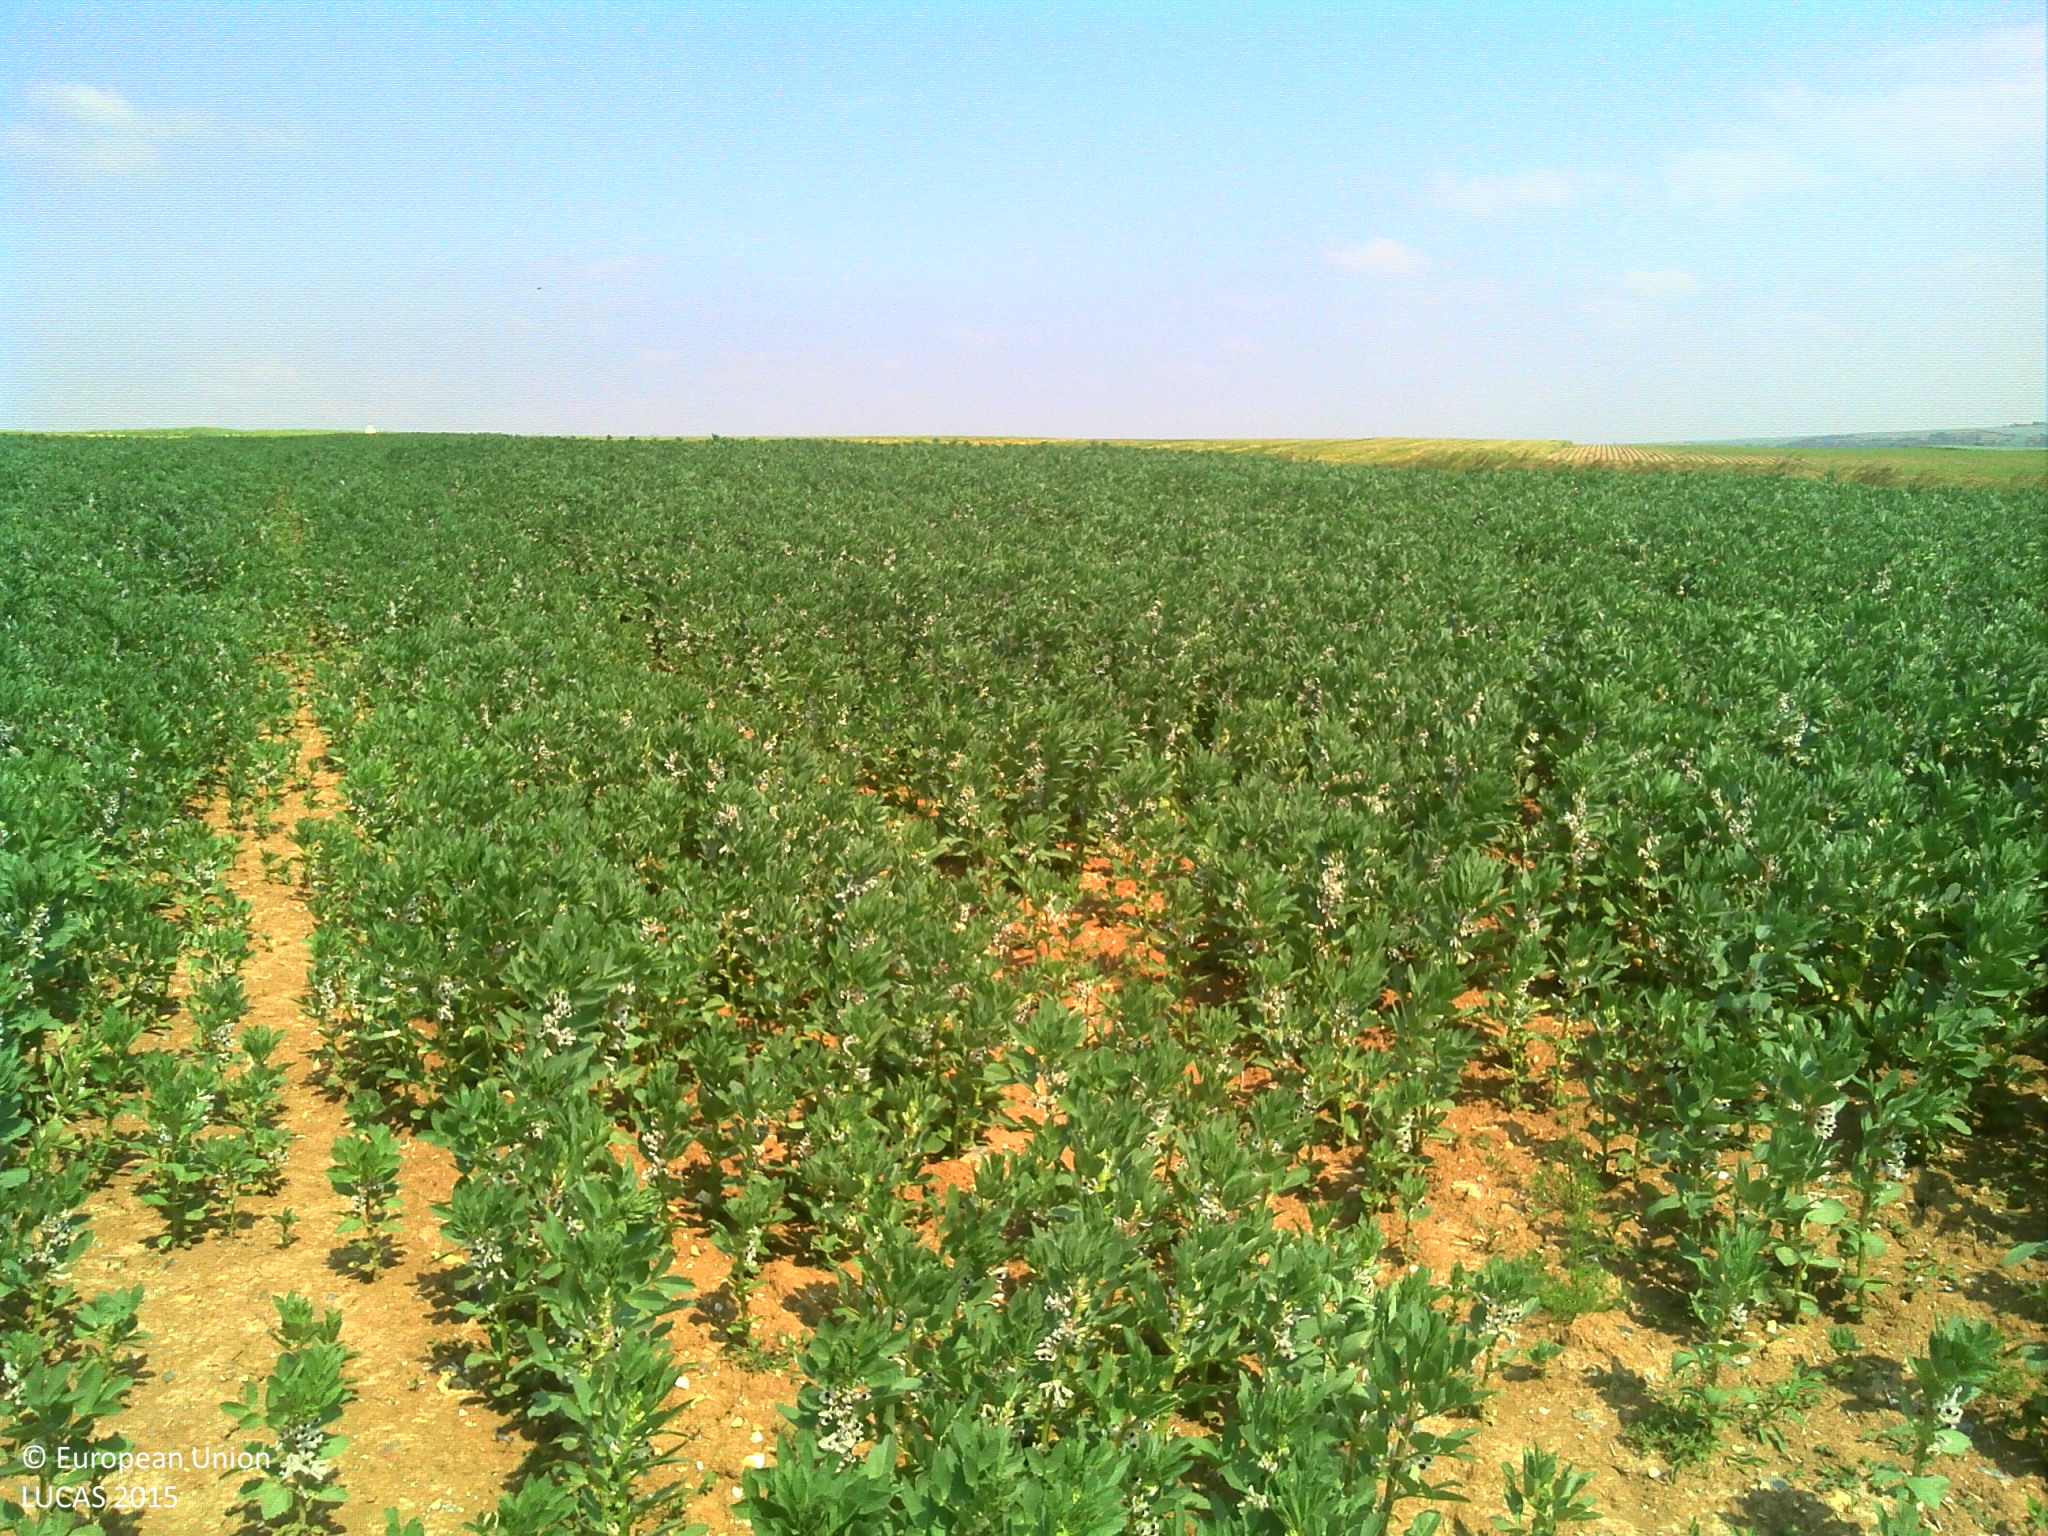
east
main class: Cropland
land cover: Dry pulses
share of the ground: > 75 %
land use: Agriculture (excluding fallow land and kitchen gardens)
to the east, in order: Dry pulses; Grass margins; Paved roads, cycling and walking lanes; Grass margins; Barley; Common wheat
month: June
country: FR
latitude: 49.7249
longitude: 4.0993
